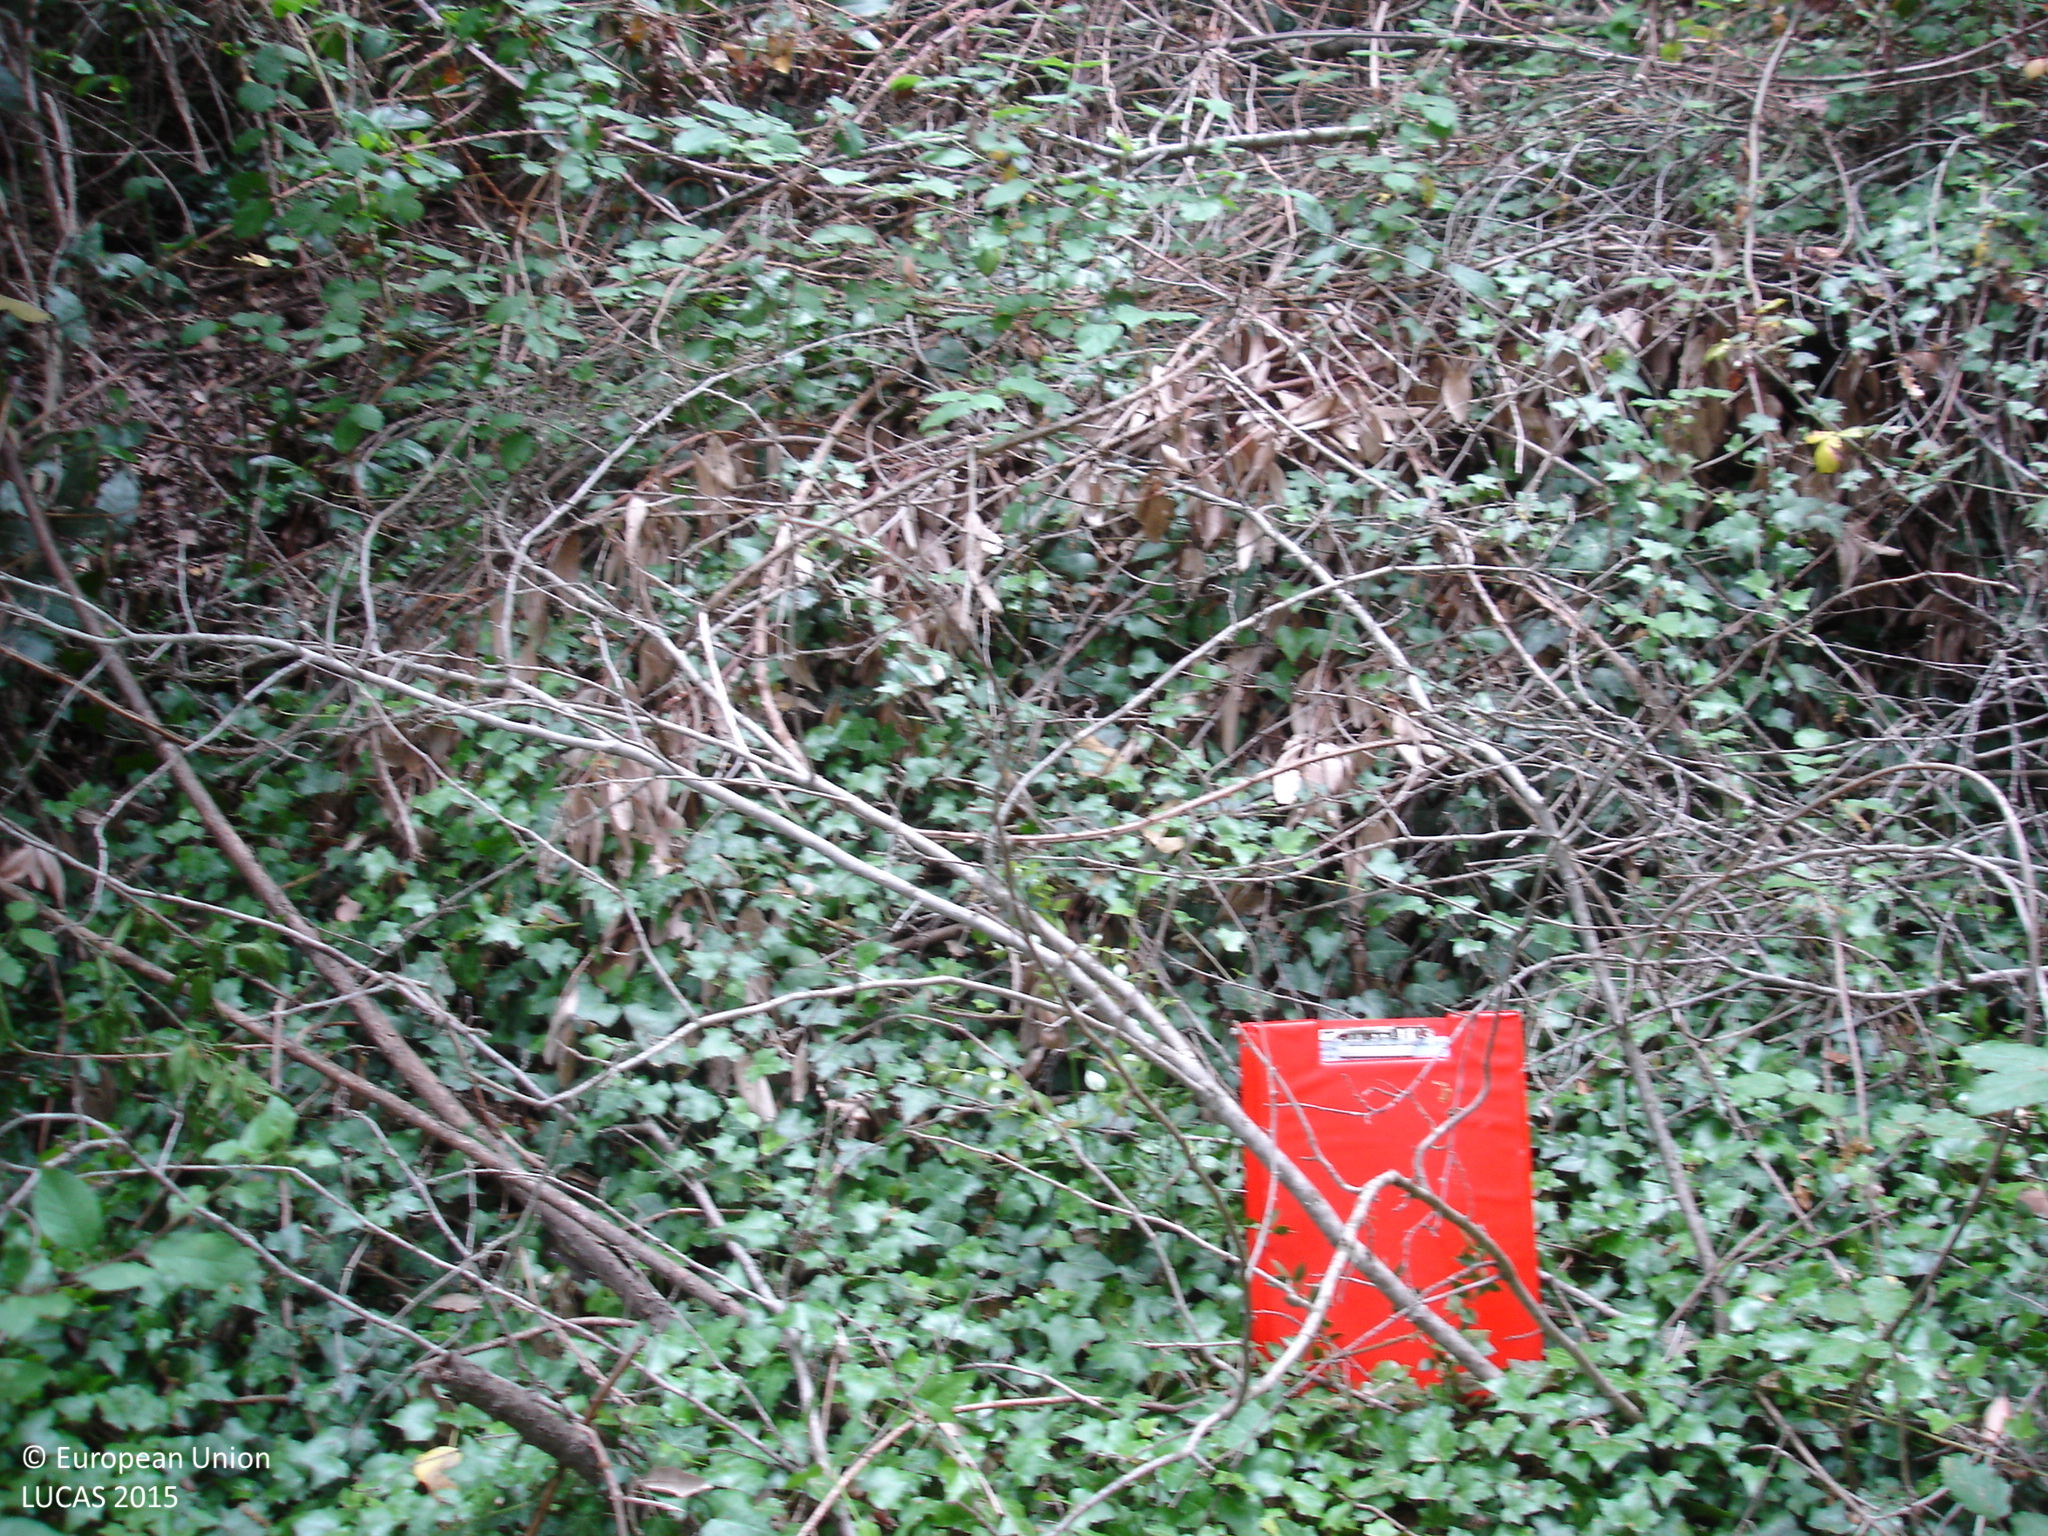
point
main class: Woodland
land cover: Broadleaved woodland
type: thermophilous deciduous forest
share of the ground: > 75 %
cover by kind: broadleaved forest trees 90 %, shrubs 10 %
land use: Forestry
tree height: > 5 m
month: June
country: ES
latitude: 41.7532
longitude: 2.1866
